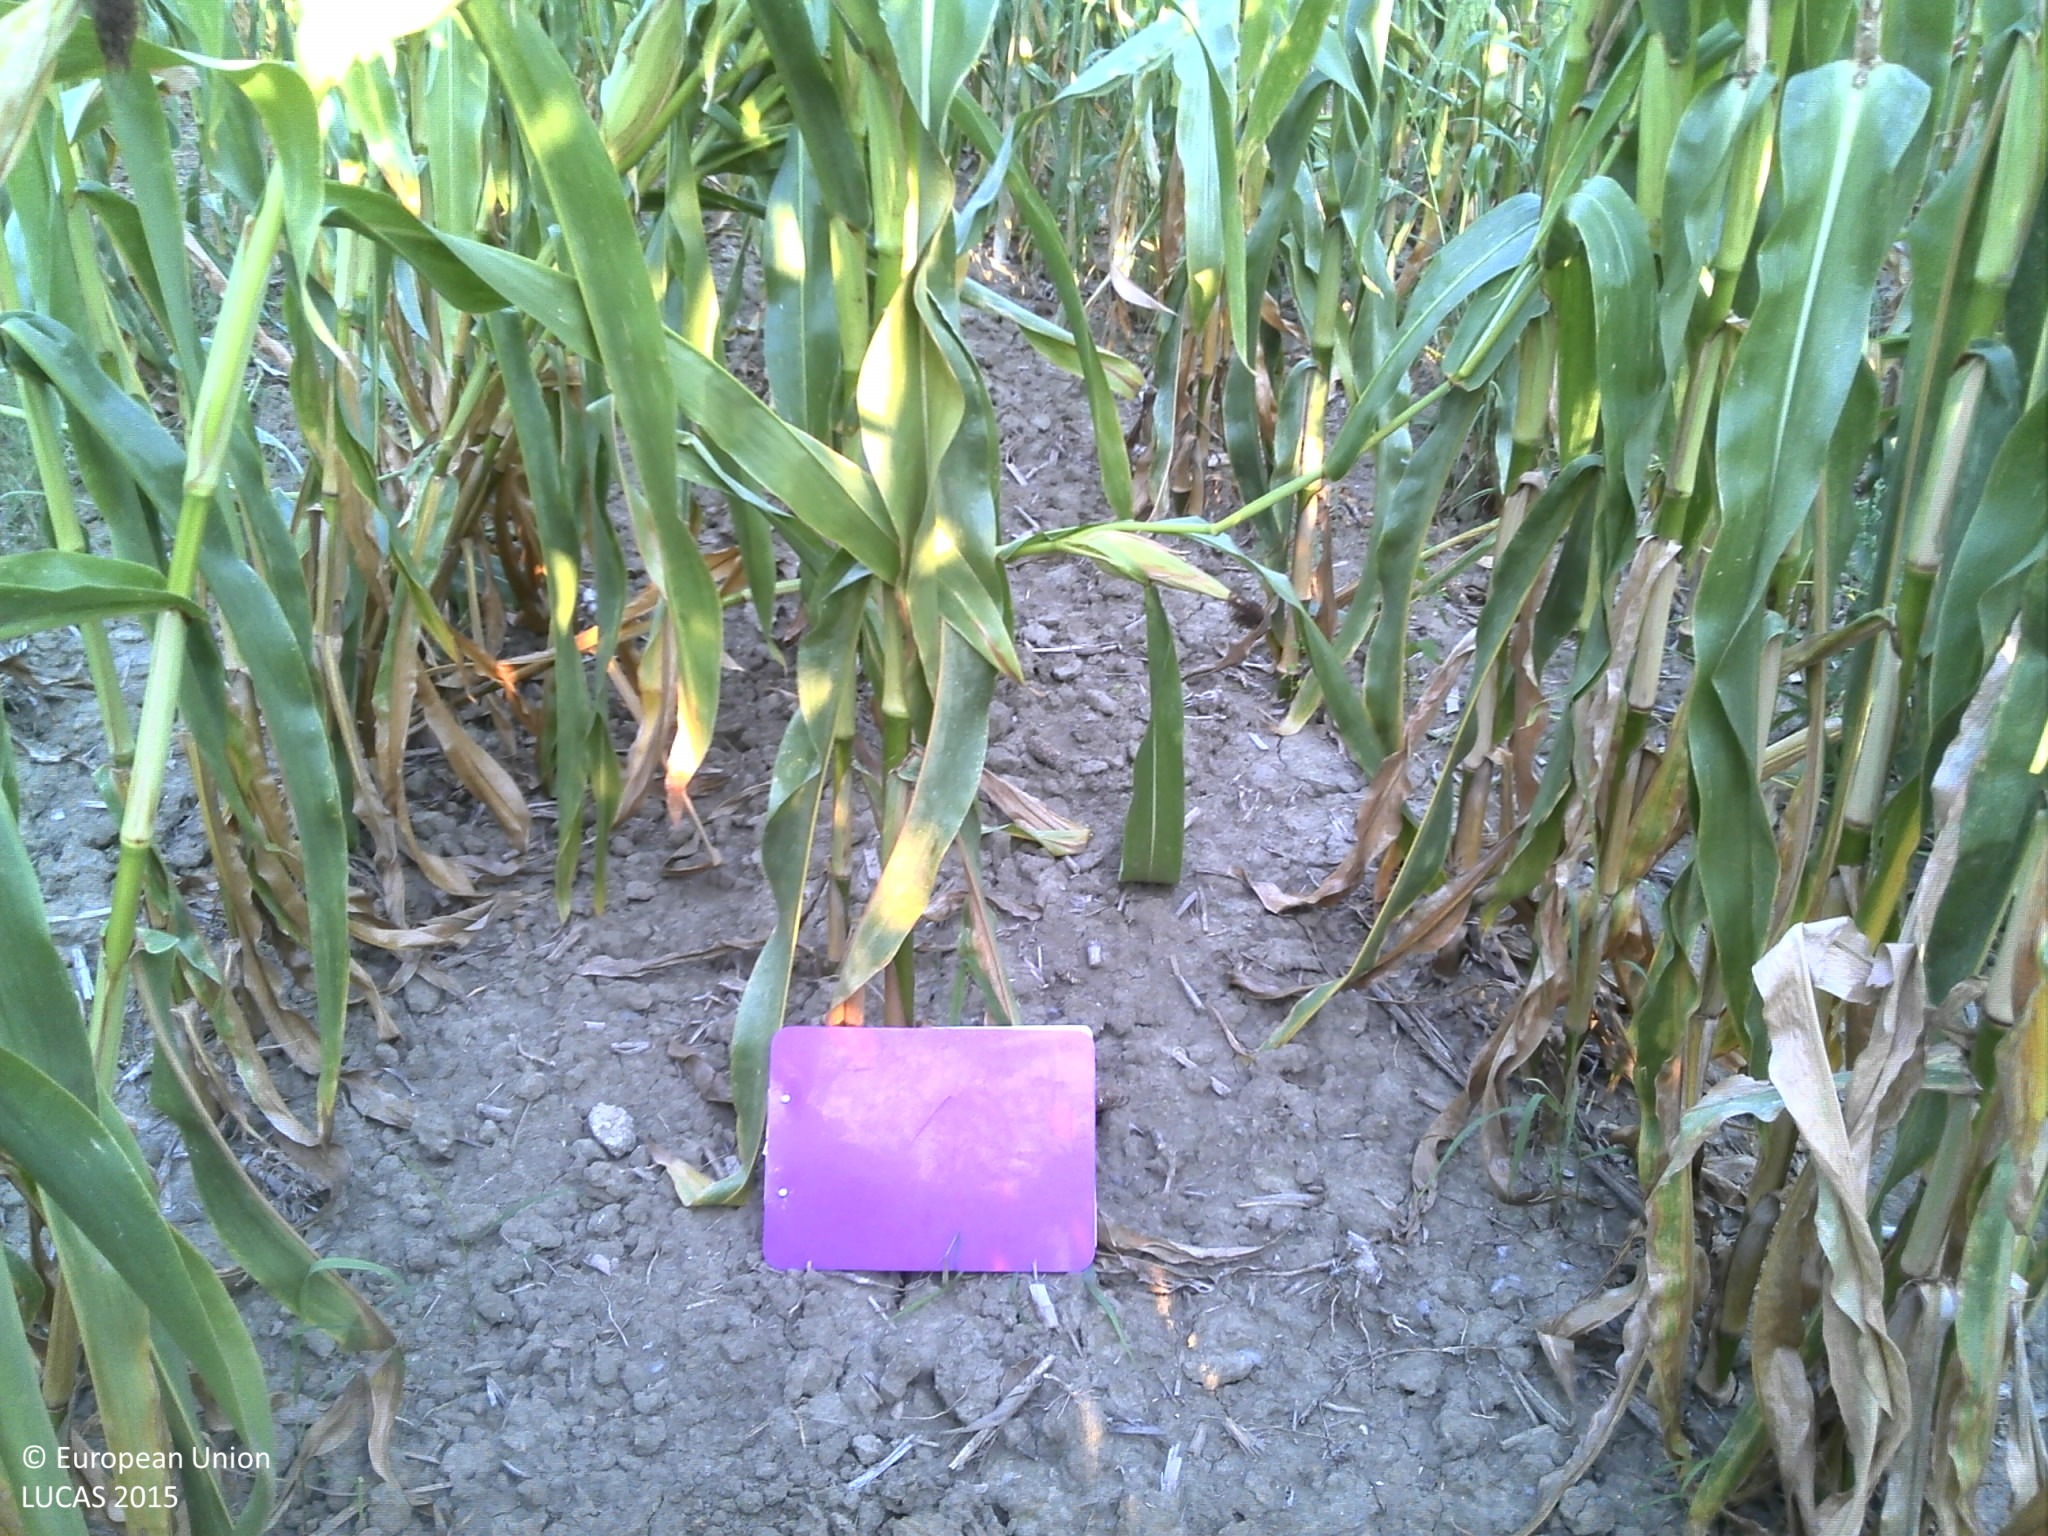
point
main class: Cropland
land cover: Maize
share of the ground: > 75 %
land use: Agriculture (excluding fallow land and kitchen gardens)
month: August
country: HR
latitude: 45.1959
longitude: 17.5746
